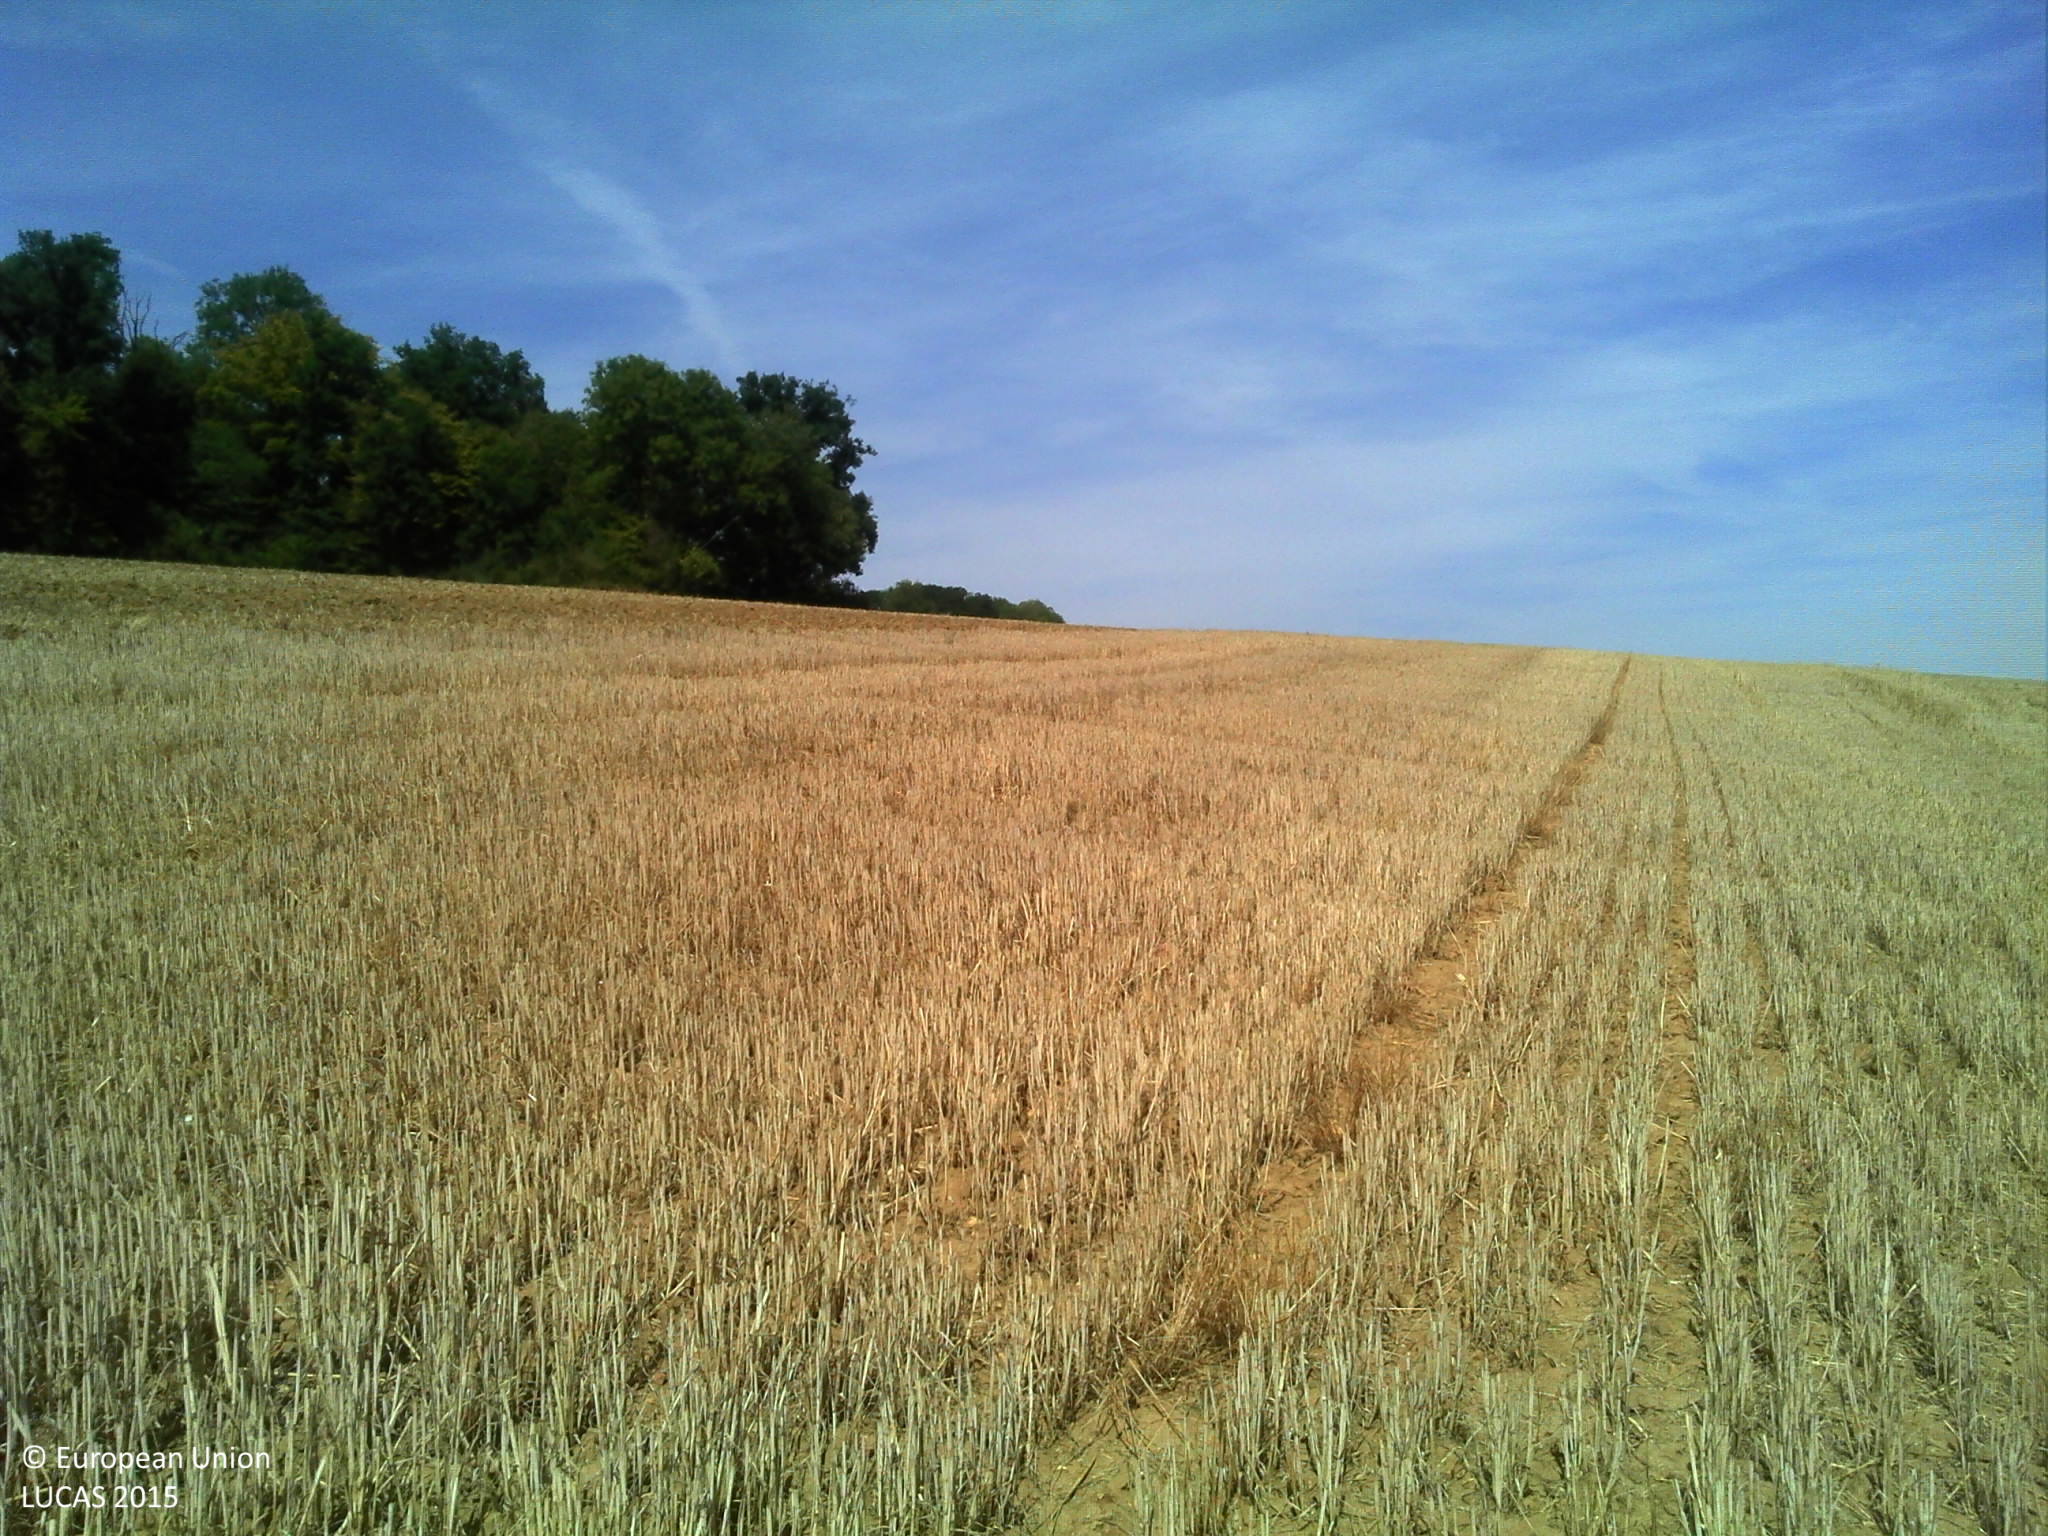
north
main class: Cropland
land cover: Common wheat
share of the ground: > 75 %
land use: Agriculture (excluding fallow land and kitchen gardens)
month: August
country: FR
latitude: 49.1235
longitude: 1.9691
